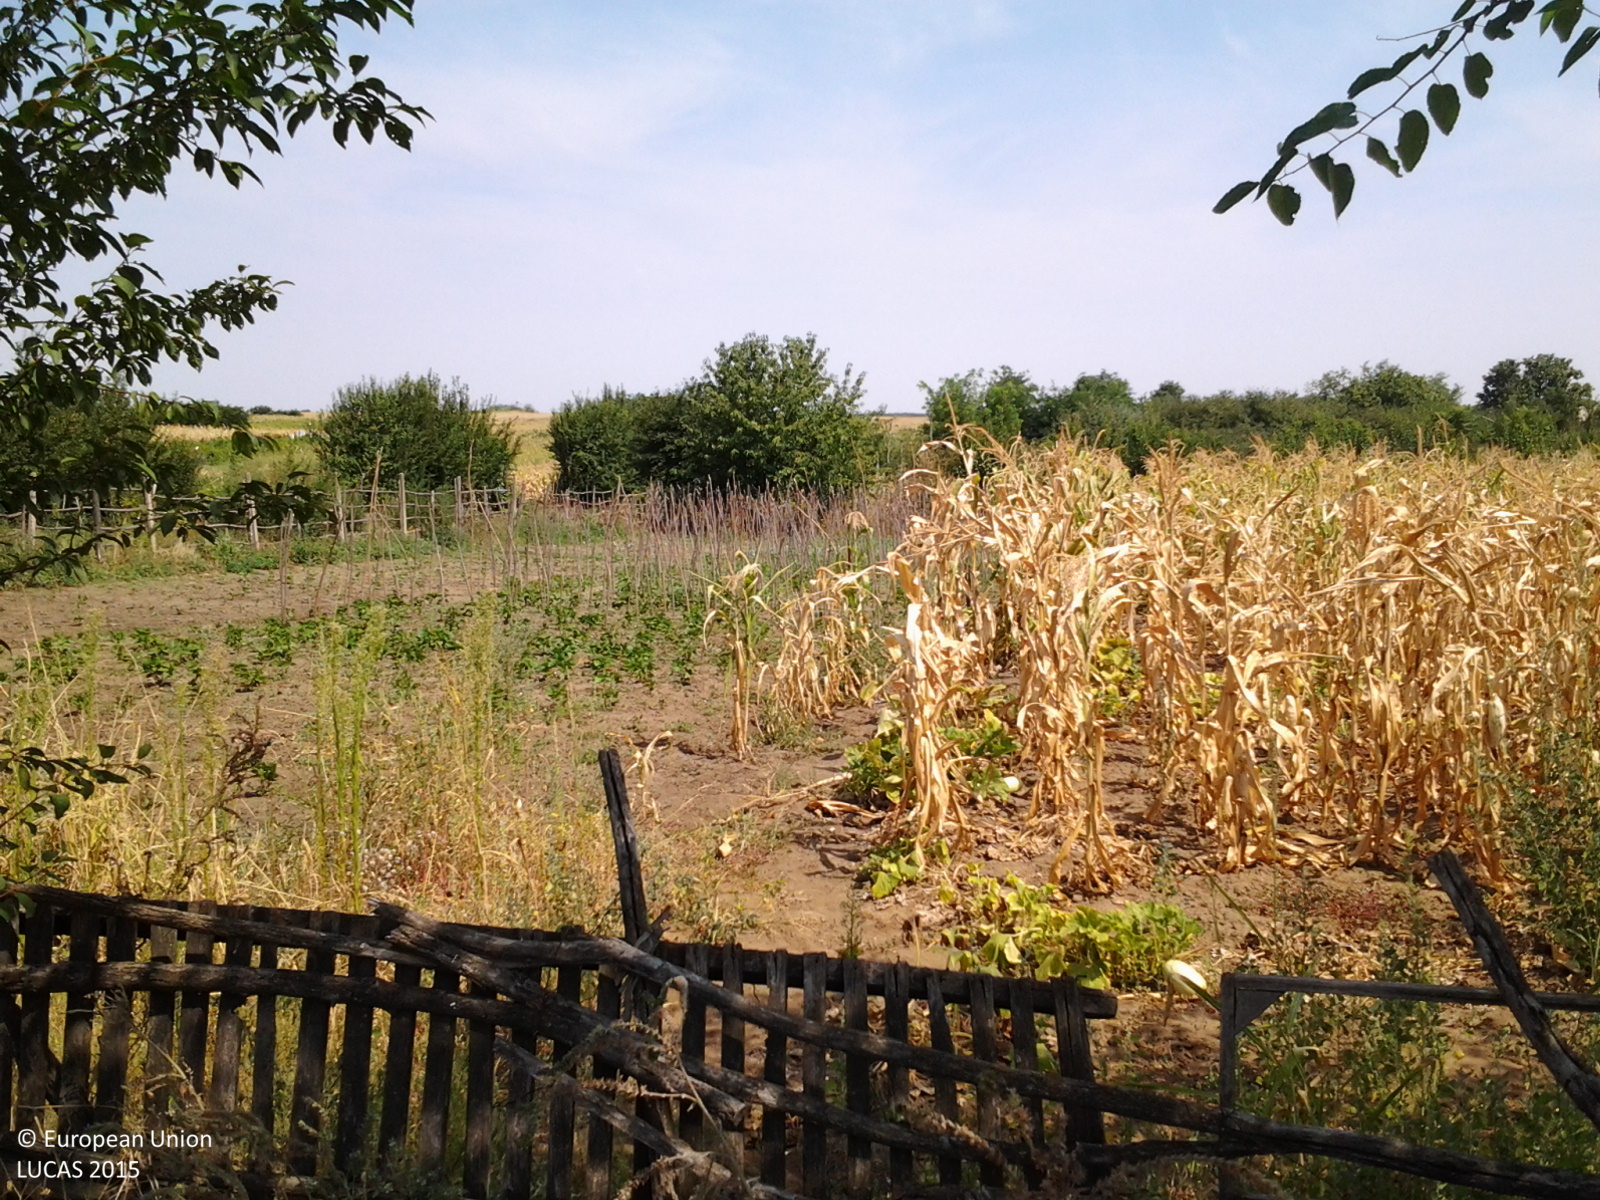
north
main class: Grassland
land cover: Spontaneously vegetated surfaces
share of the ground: > 75 %
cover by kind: herbaceous plants 100 %
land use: Semi-natural and natural areas not in use
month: August
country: RO
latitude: 43.9356
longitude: 22.9586
